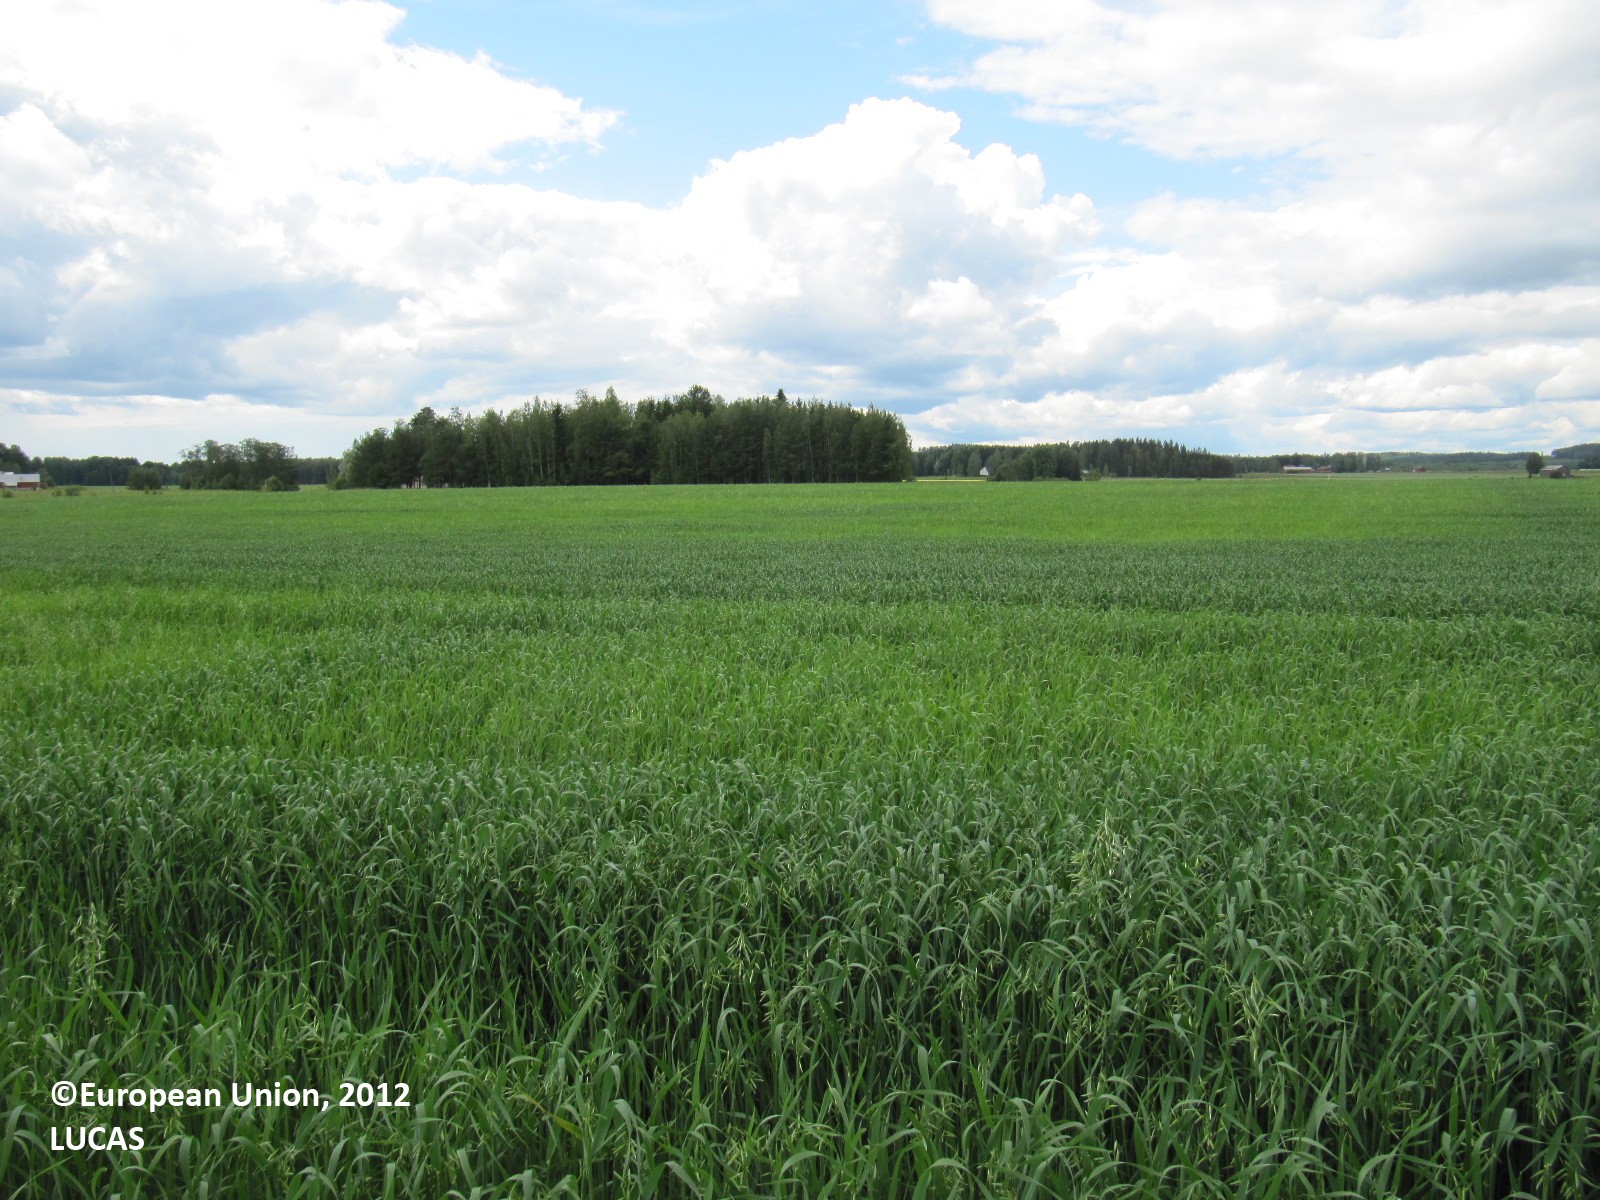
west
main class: Cropland
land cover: Oats
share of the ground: > 75 %
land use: Agriculture (excluding fallow land and kitchen gardens)
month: July
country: FI
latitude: 60.7847
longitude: 24.6727
